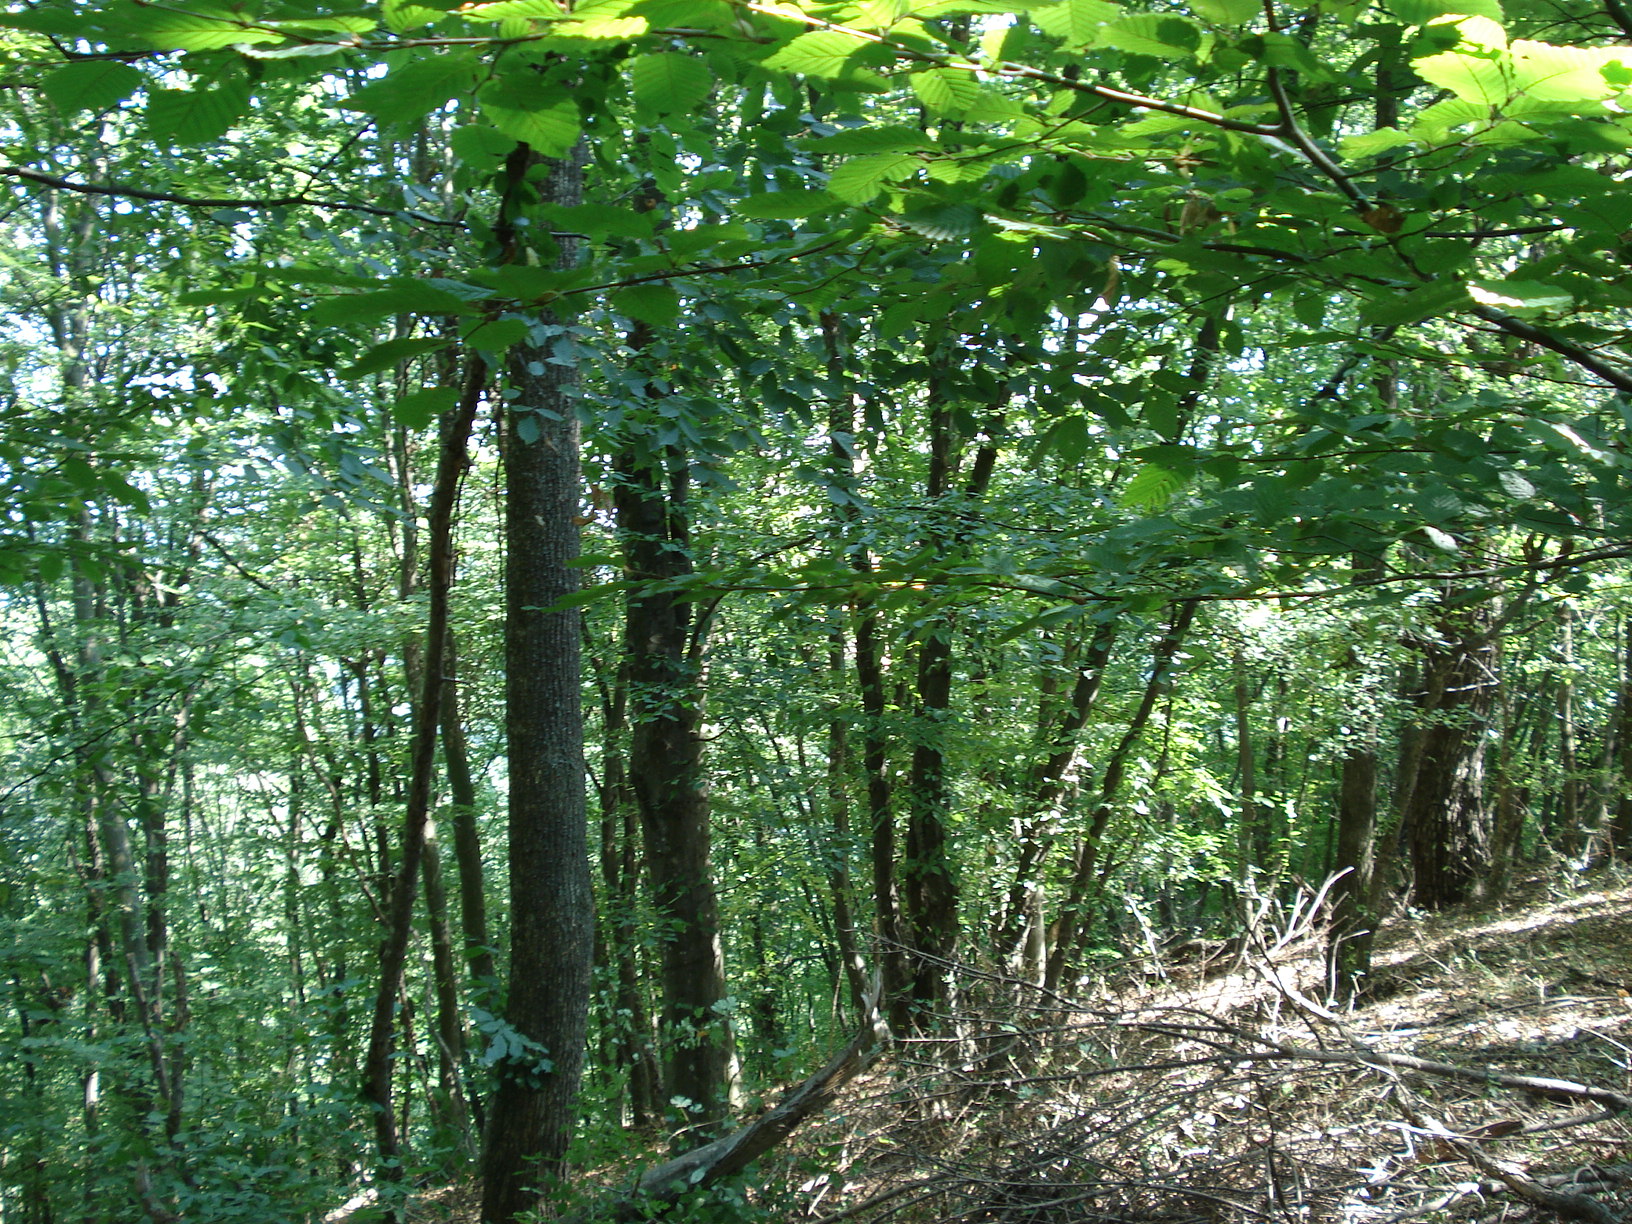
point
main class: Woodland
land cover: Broadleaved woodland
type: beech forest
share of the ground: > 75 %
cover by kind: broadleaved forest trees 80 %, unconsolidated bare surface 20 %
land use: Forestry
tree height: > 5 m
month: September
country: BG
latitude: 43.2110
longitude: 26.1057
